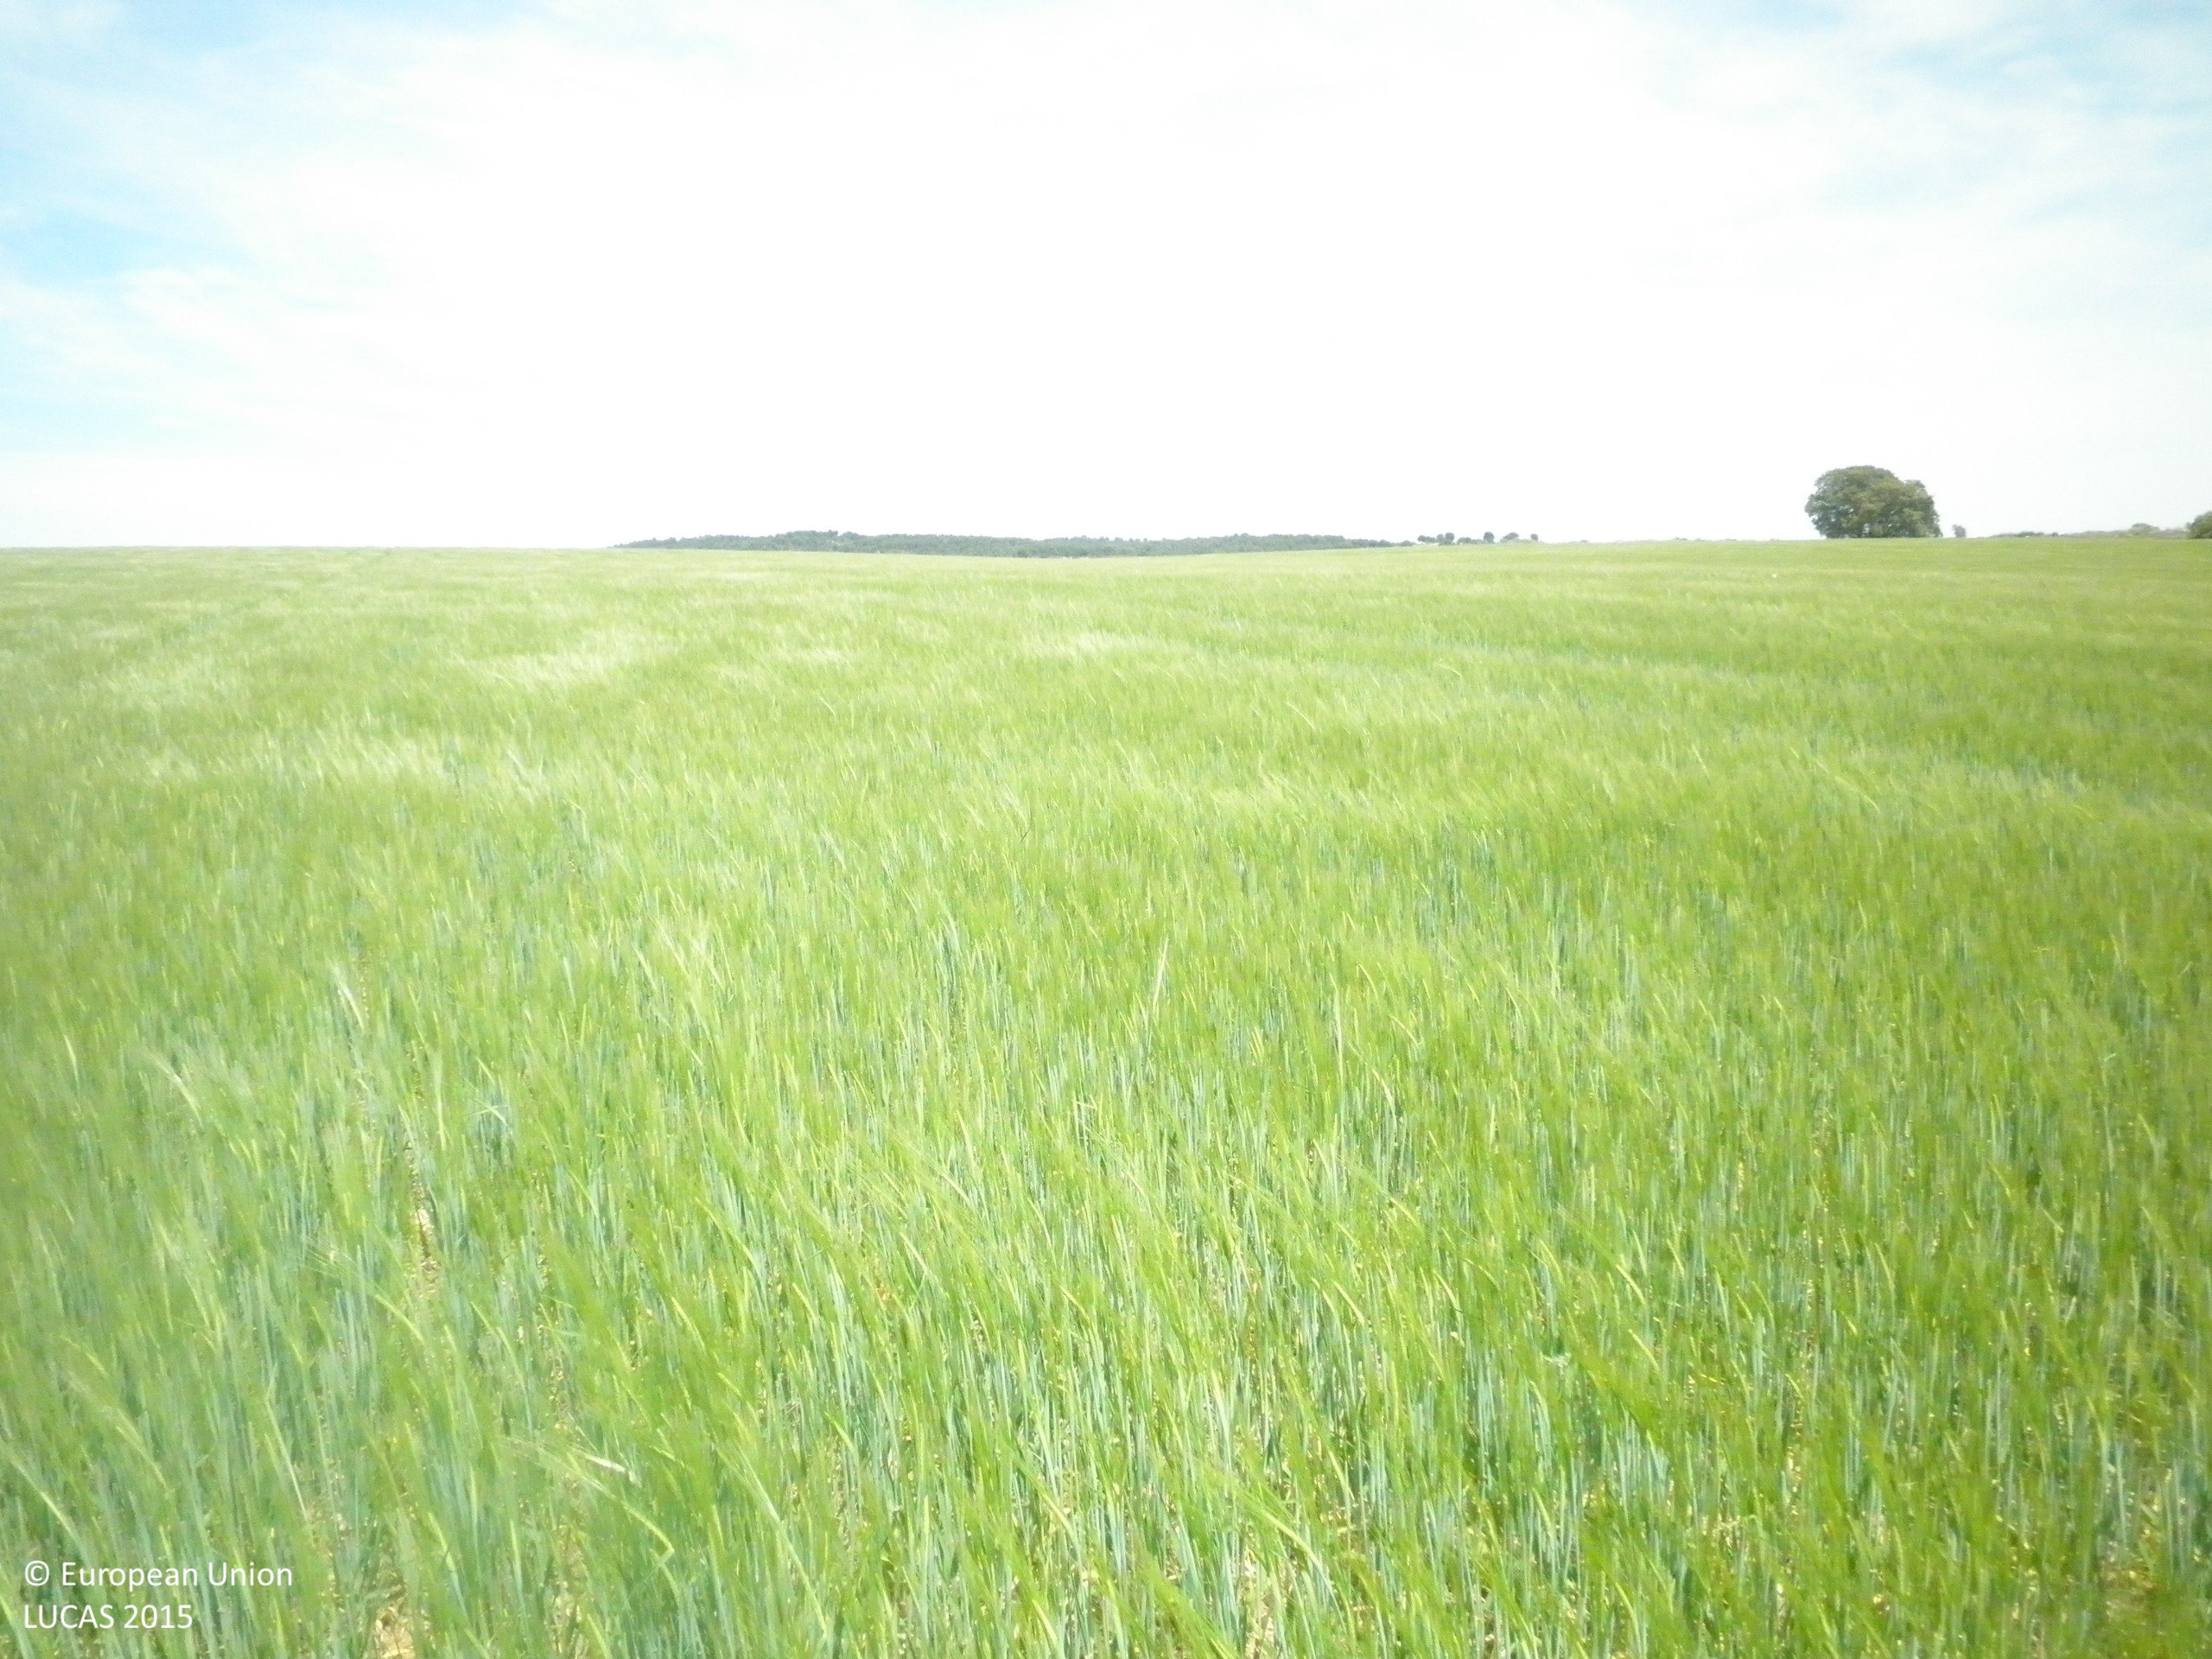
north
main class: Cropland
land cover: Barley
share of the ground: > 75 %
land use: Agriculture (excluding fallow land and kitchen gardens)
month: May
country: ES
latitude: 39.7015
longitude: -2.6468
